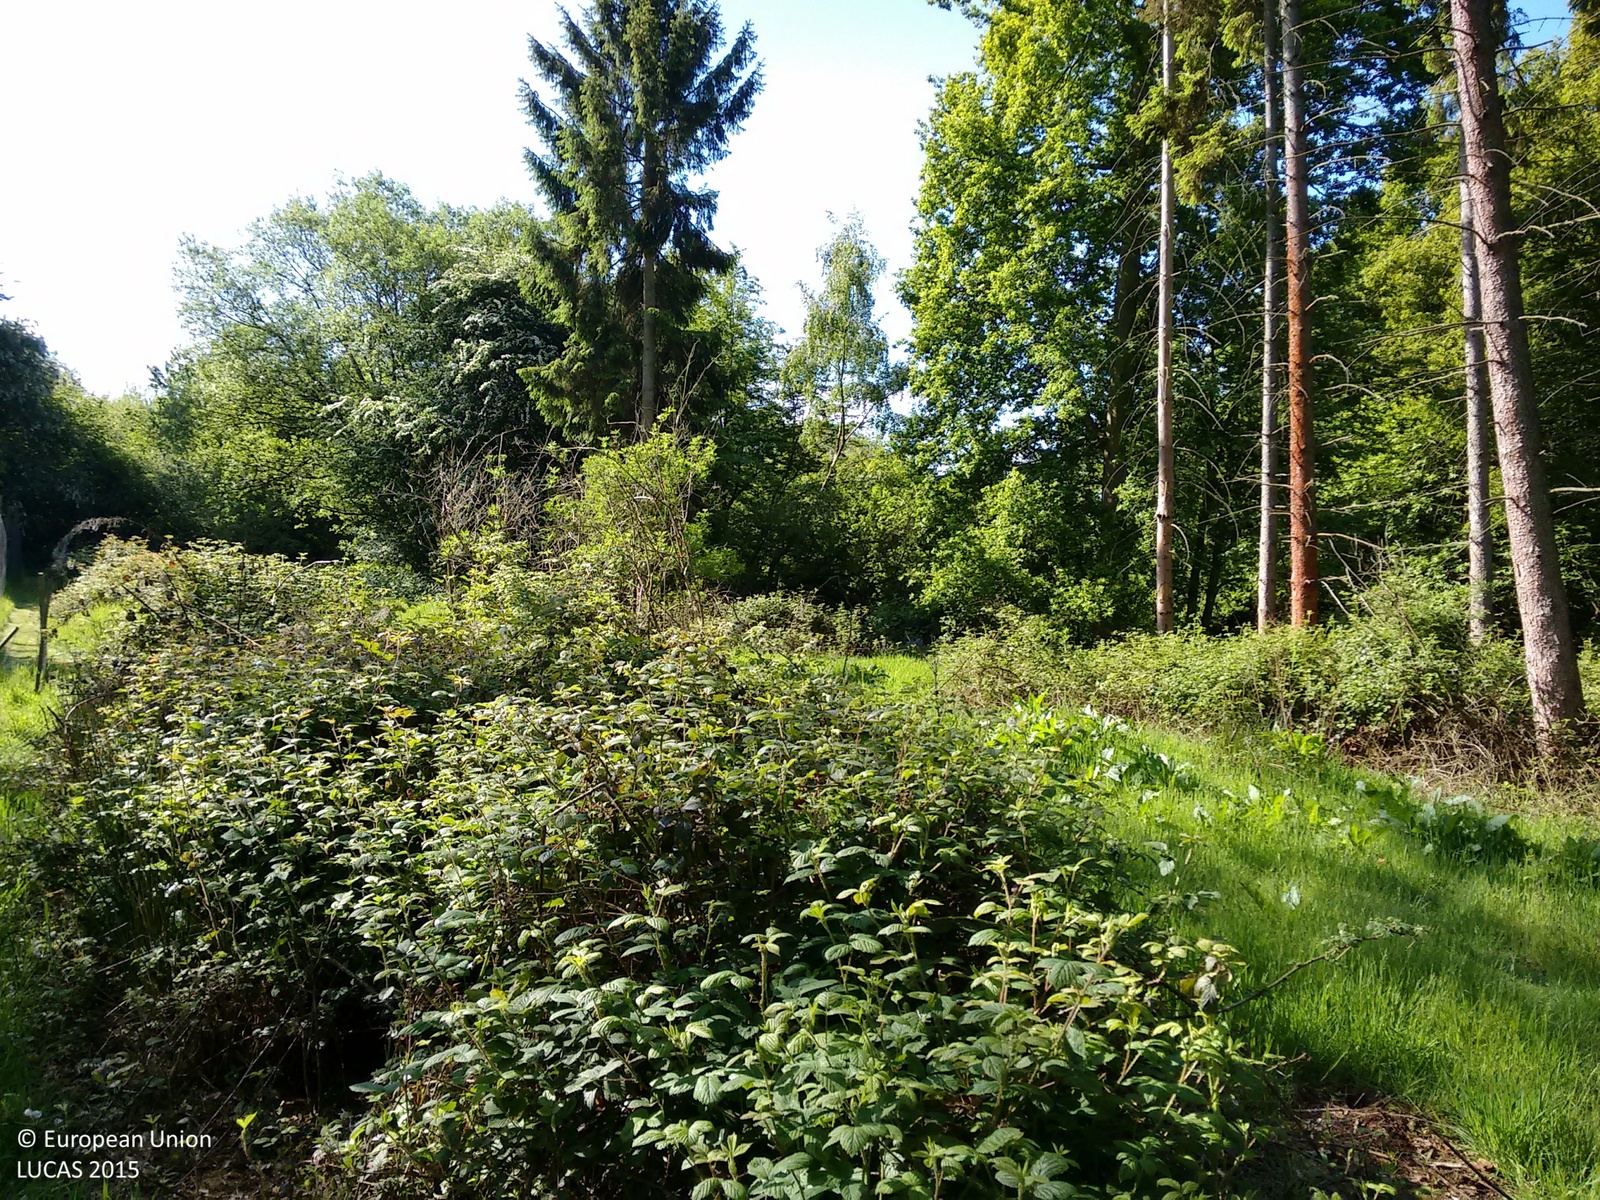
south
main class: Woodland
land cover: Other mixed woodland
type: hemiboreal forest and nemoral coniferous forest and mixed broadleaved-coniferous forest
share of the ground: > 75 %
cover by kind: broadleaved forest trees 60 %, coniferous forest trees 30 %, herbaceous plants 10 %
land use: Forestry
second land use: Agriculture (excluding fallow land and kitchen gardens)
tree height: > 5 m
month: May
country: GB
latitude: 51.8937
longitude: -0.2804
